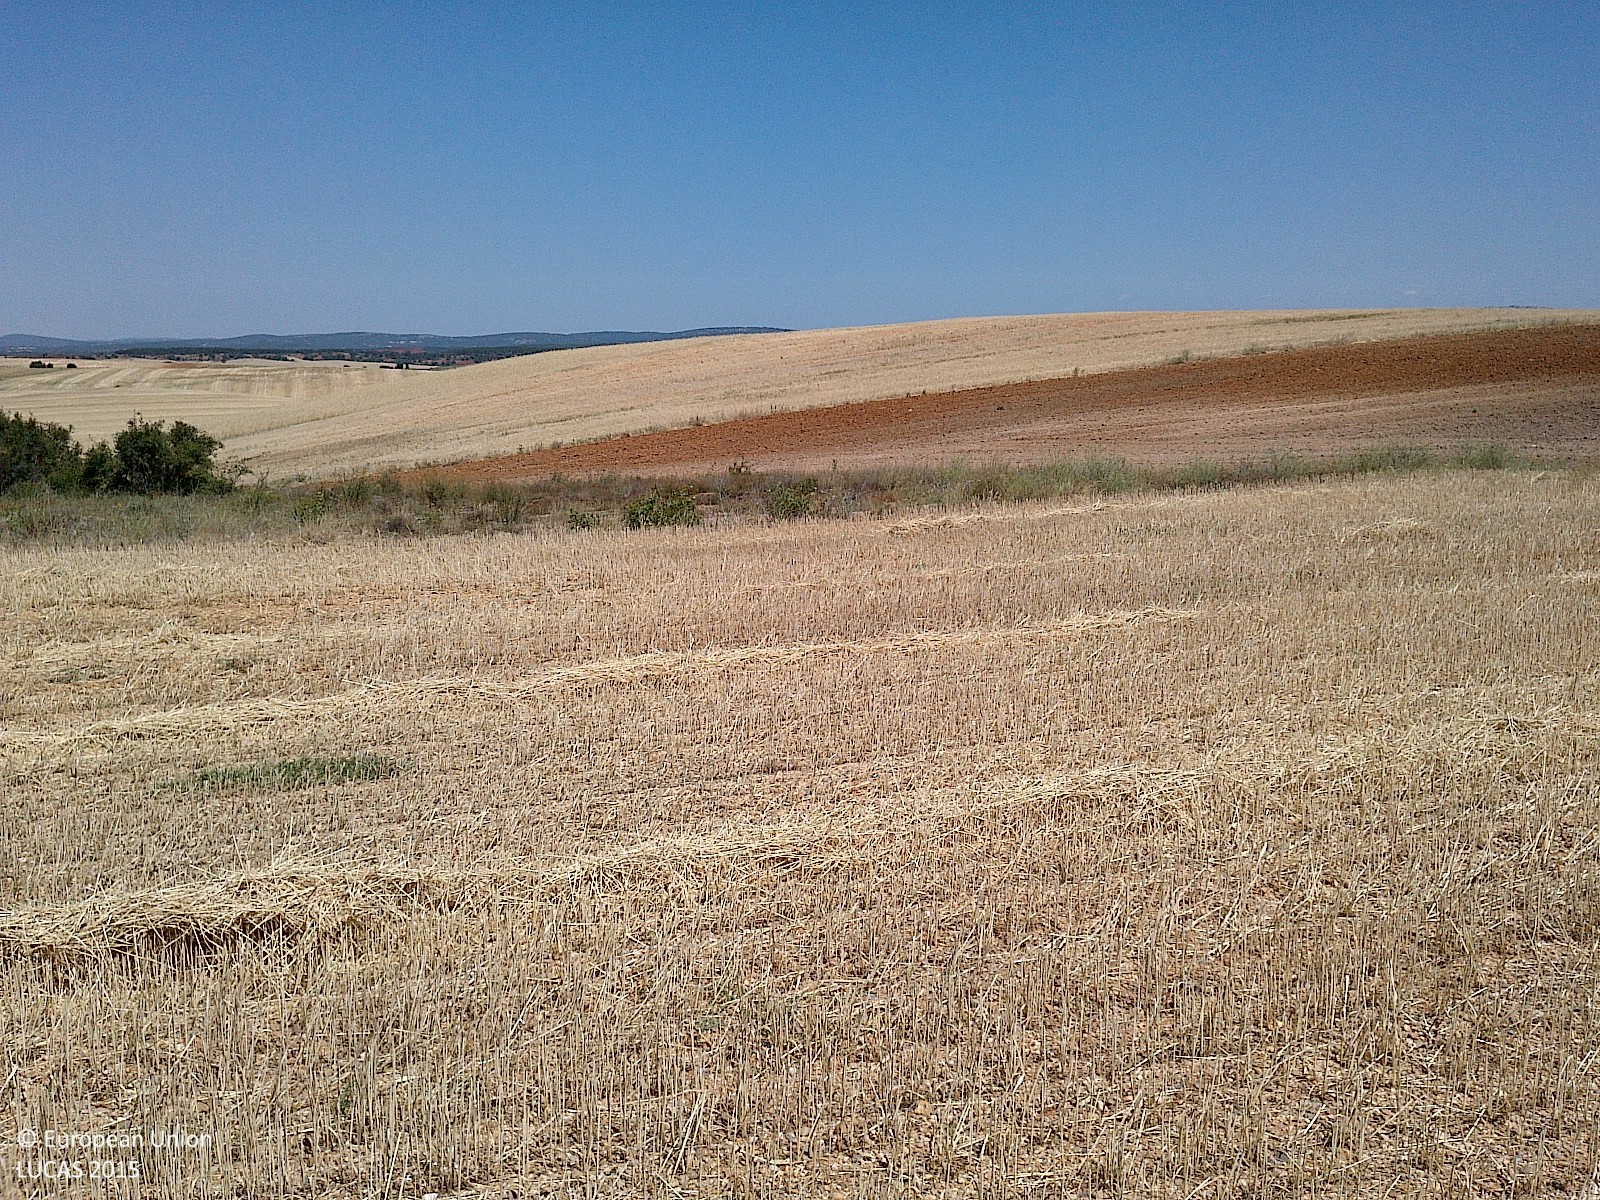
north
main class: Cropland
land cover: Common wheat
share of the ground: < 10 %
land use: Agriculture (excluding fallow land and kitchen gardens)
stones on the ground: 10 - 25 %
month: July
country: ES
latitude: 41.7411
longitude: -3.2622
